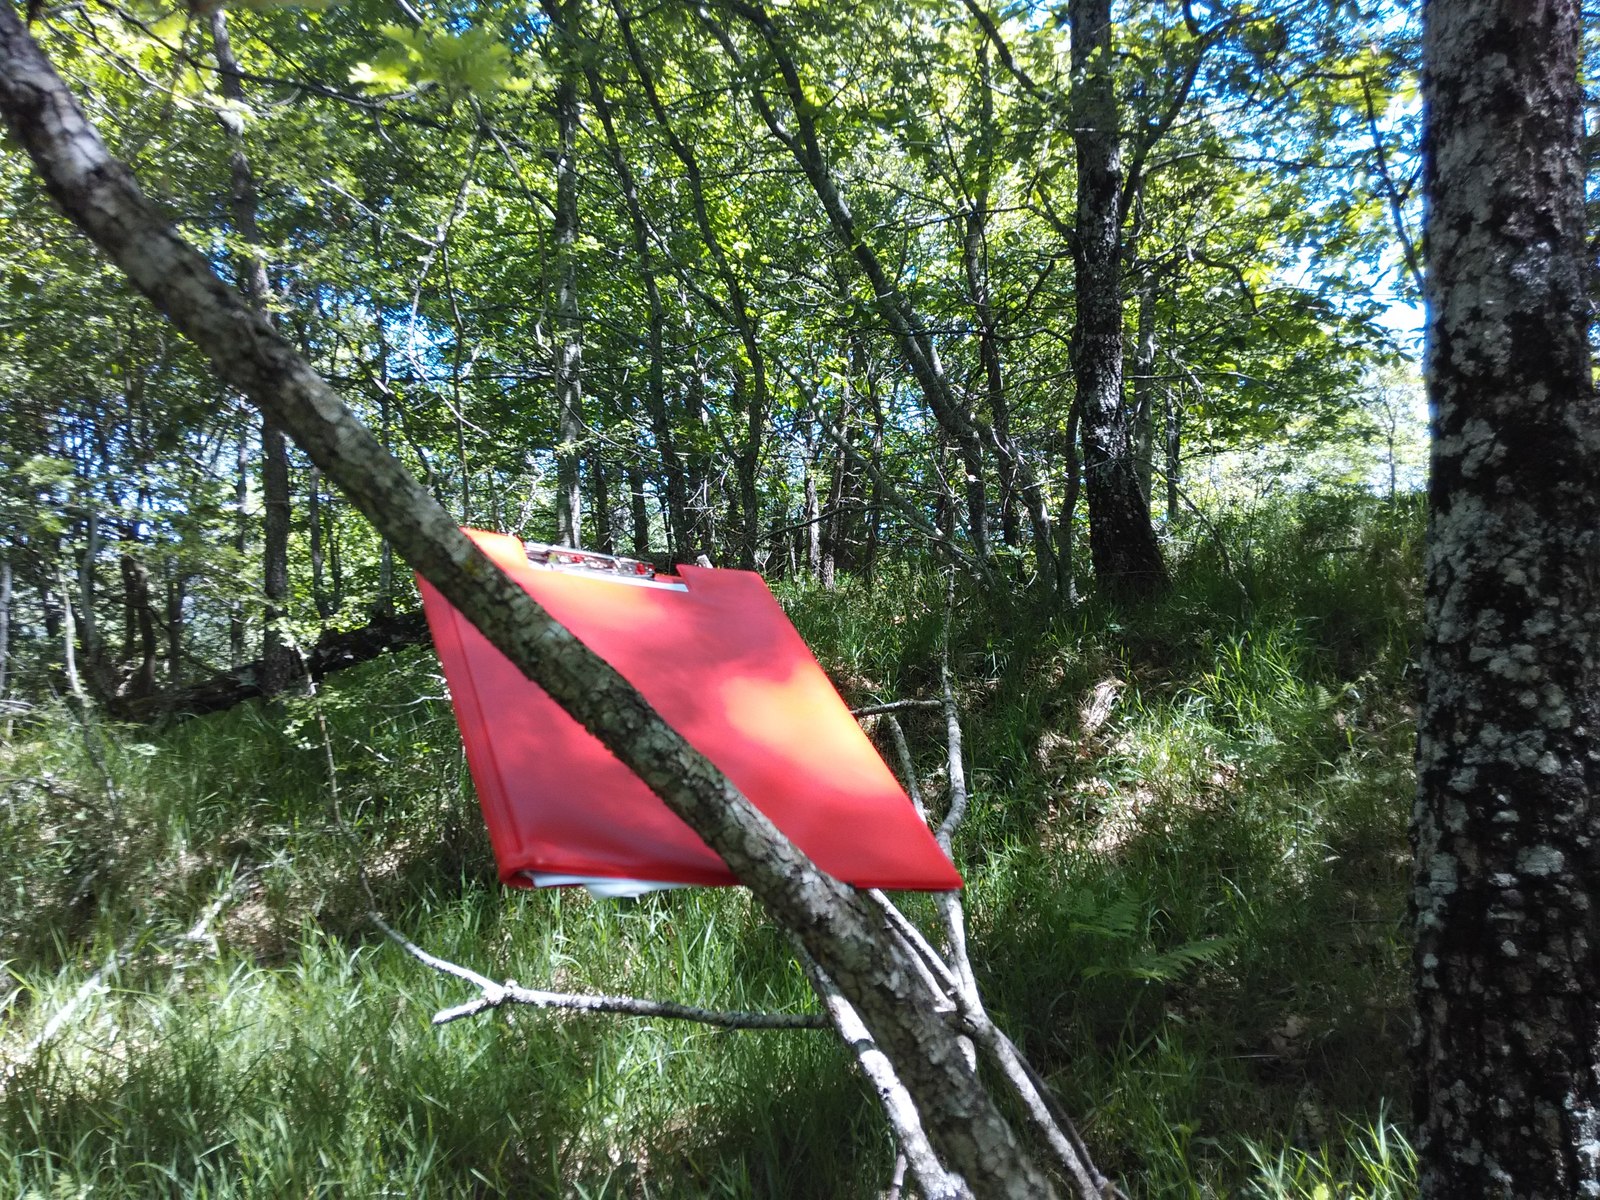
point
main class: Woodland
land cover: Broadleaved woodland
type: acidophilous oak and oak-birch forest
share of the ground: > 75 %
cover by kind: broadleaved forest trees 80 %, shrubs 10 %, herbaceous plants 10 %
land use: Forestry
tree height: > 5 m
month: May
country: ES
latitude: 42.6904
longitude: -2.4108
